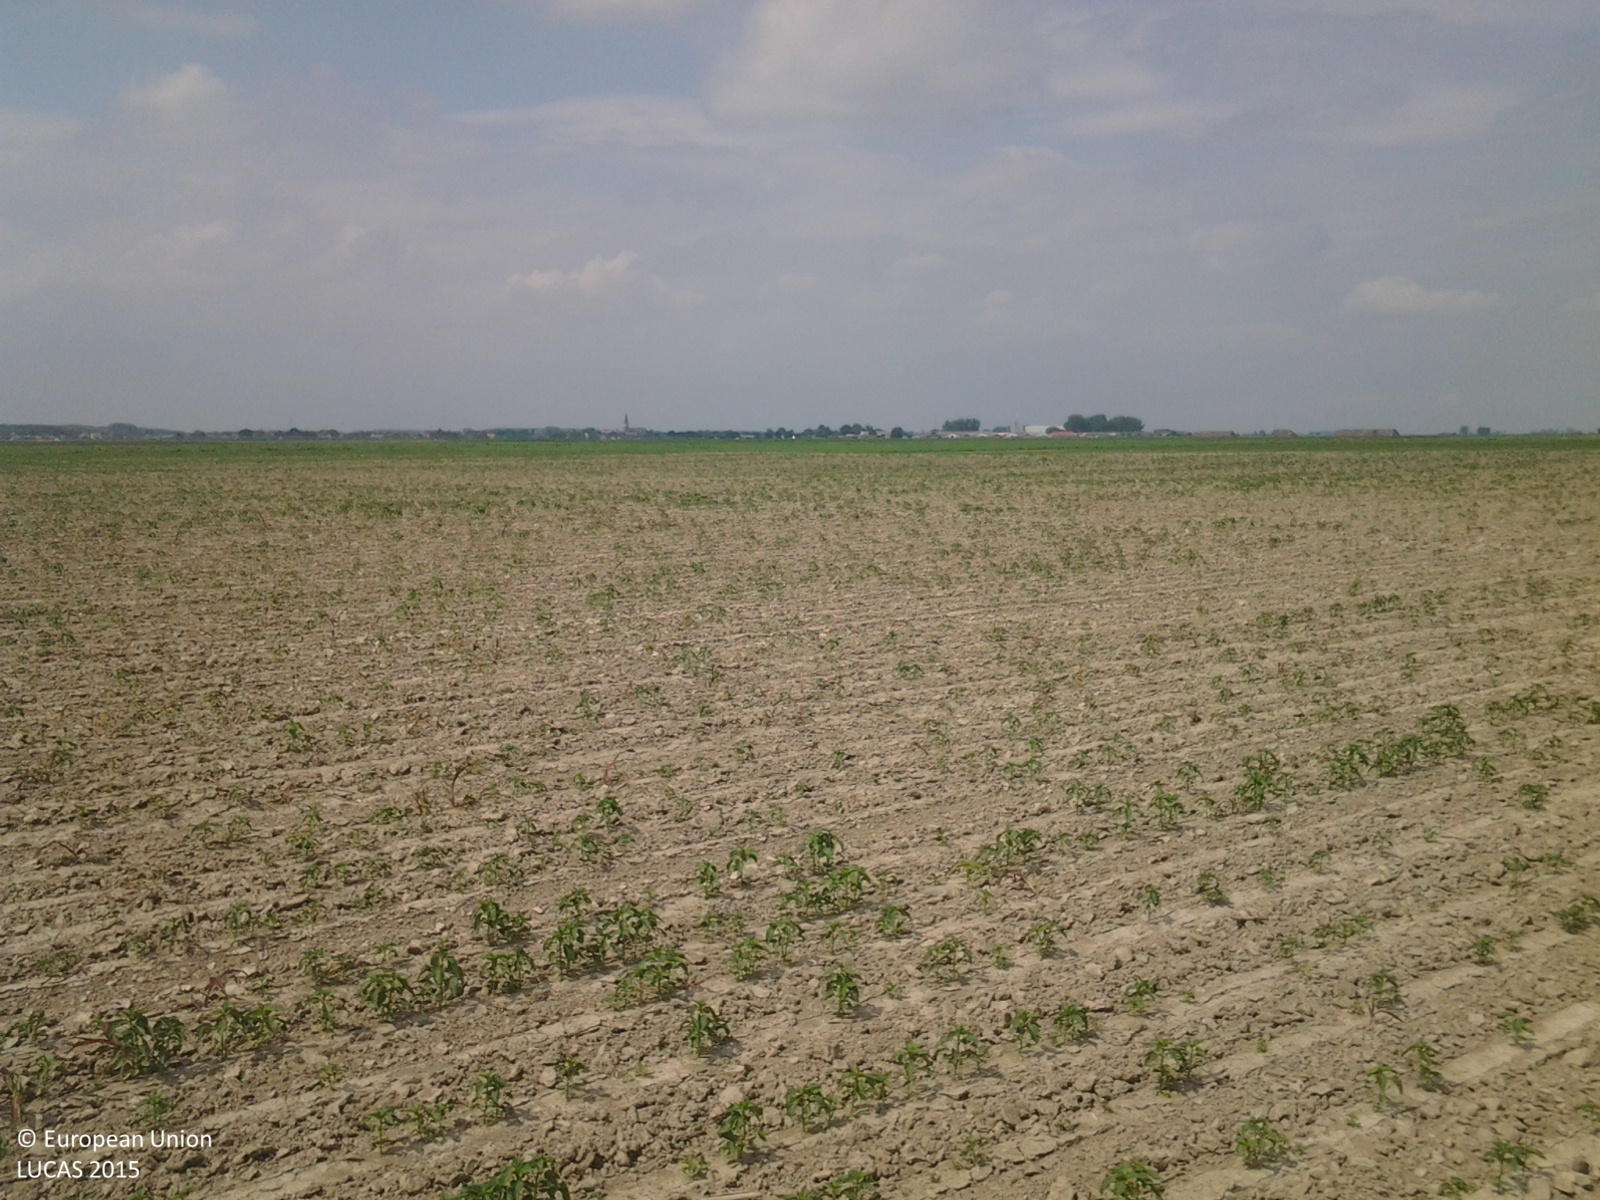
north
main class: Cropland
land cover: Other fresh vegetables
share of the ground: < 10 %
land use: Agriculture (excluding fallow land and kitchen gardens)
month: June
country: HU
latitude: 46.3945
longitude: 18.9212
